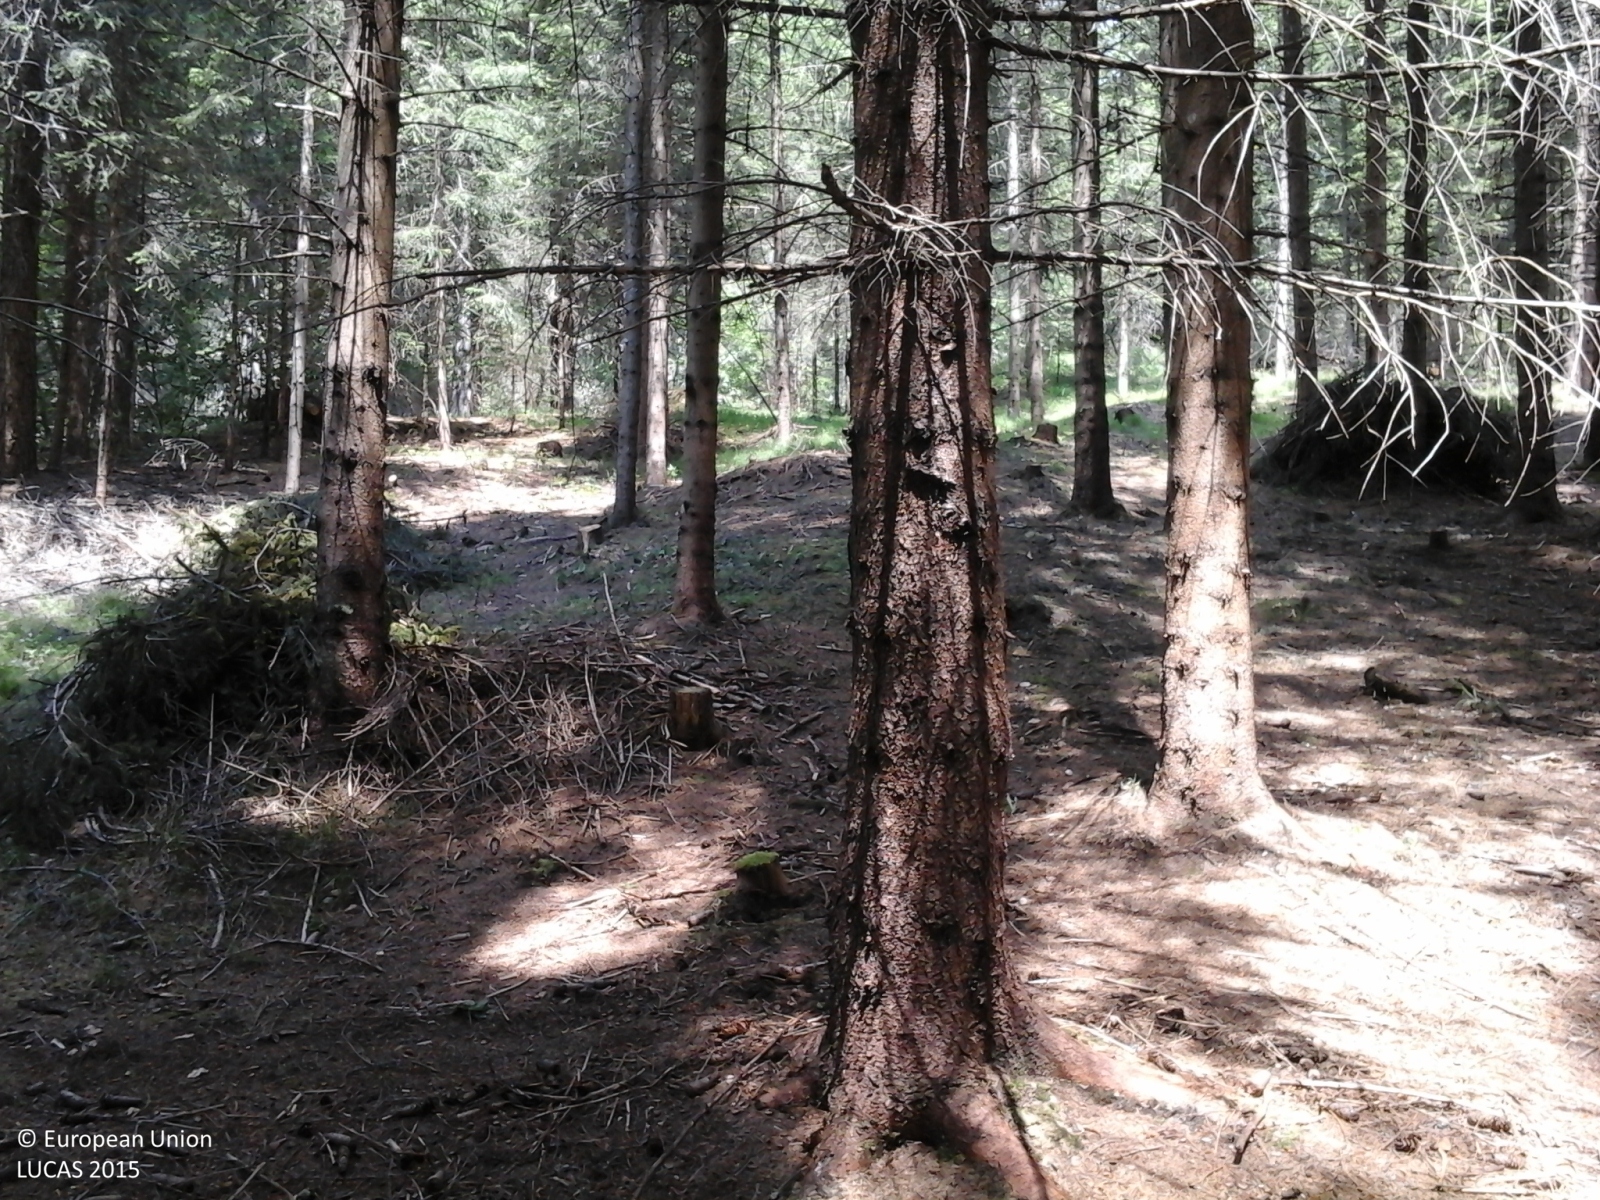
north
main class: Woodland
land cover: Spruce dominated coniferous woodland
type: alpine coniferous forest
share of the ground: > 75 %
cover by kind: coniferous forest trees 95 %, herbaceous plants 5 %
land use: Forestry
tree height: > 5 m
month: June
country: IT
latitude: 46.5701
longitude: 12.6720
